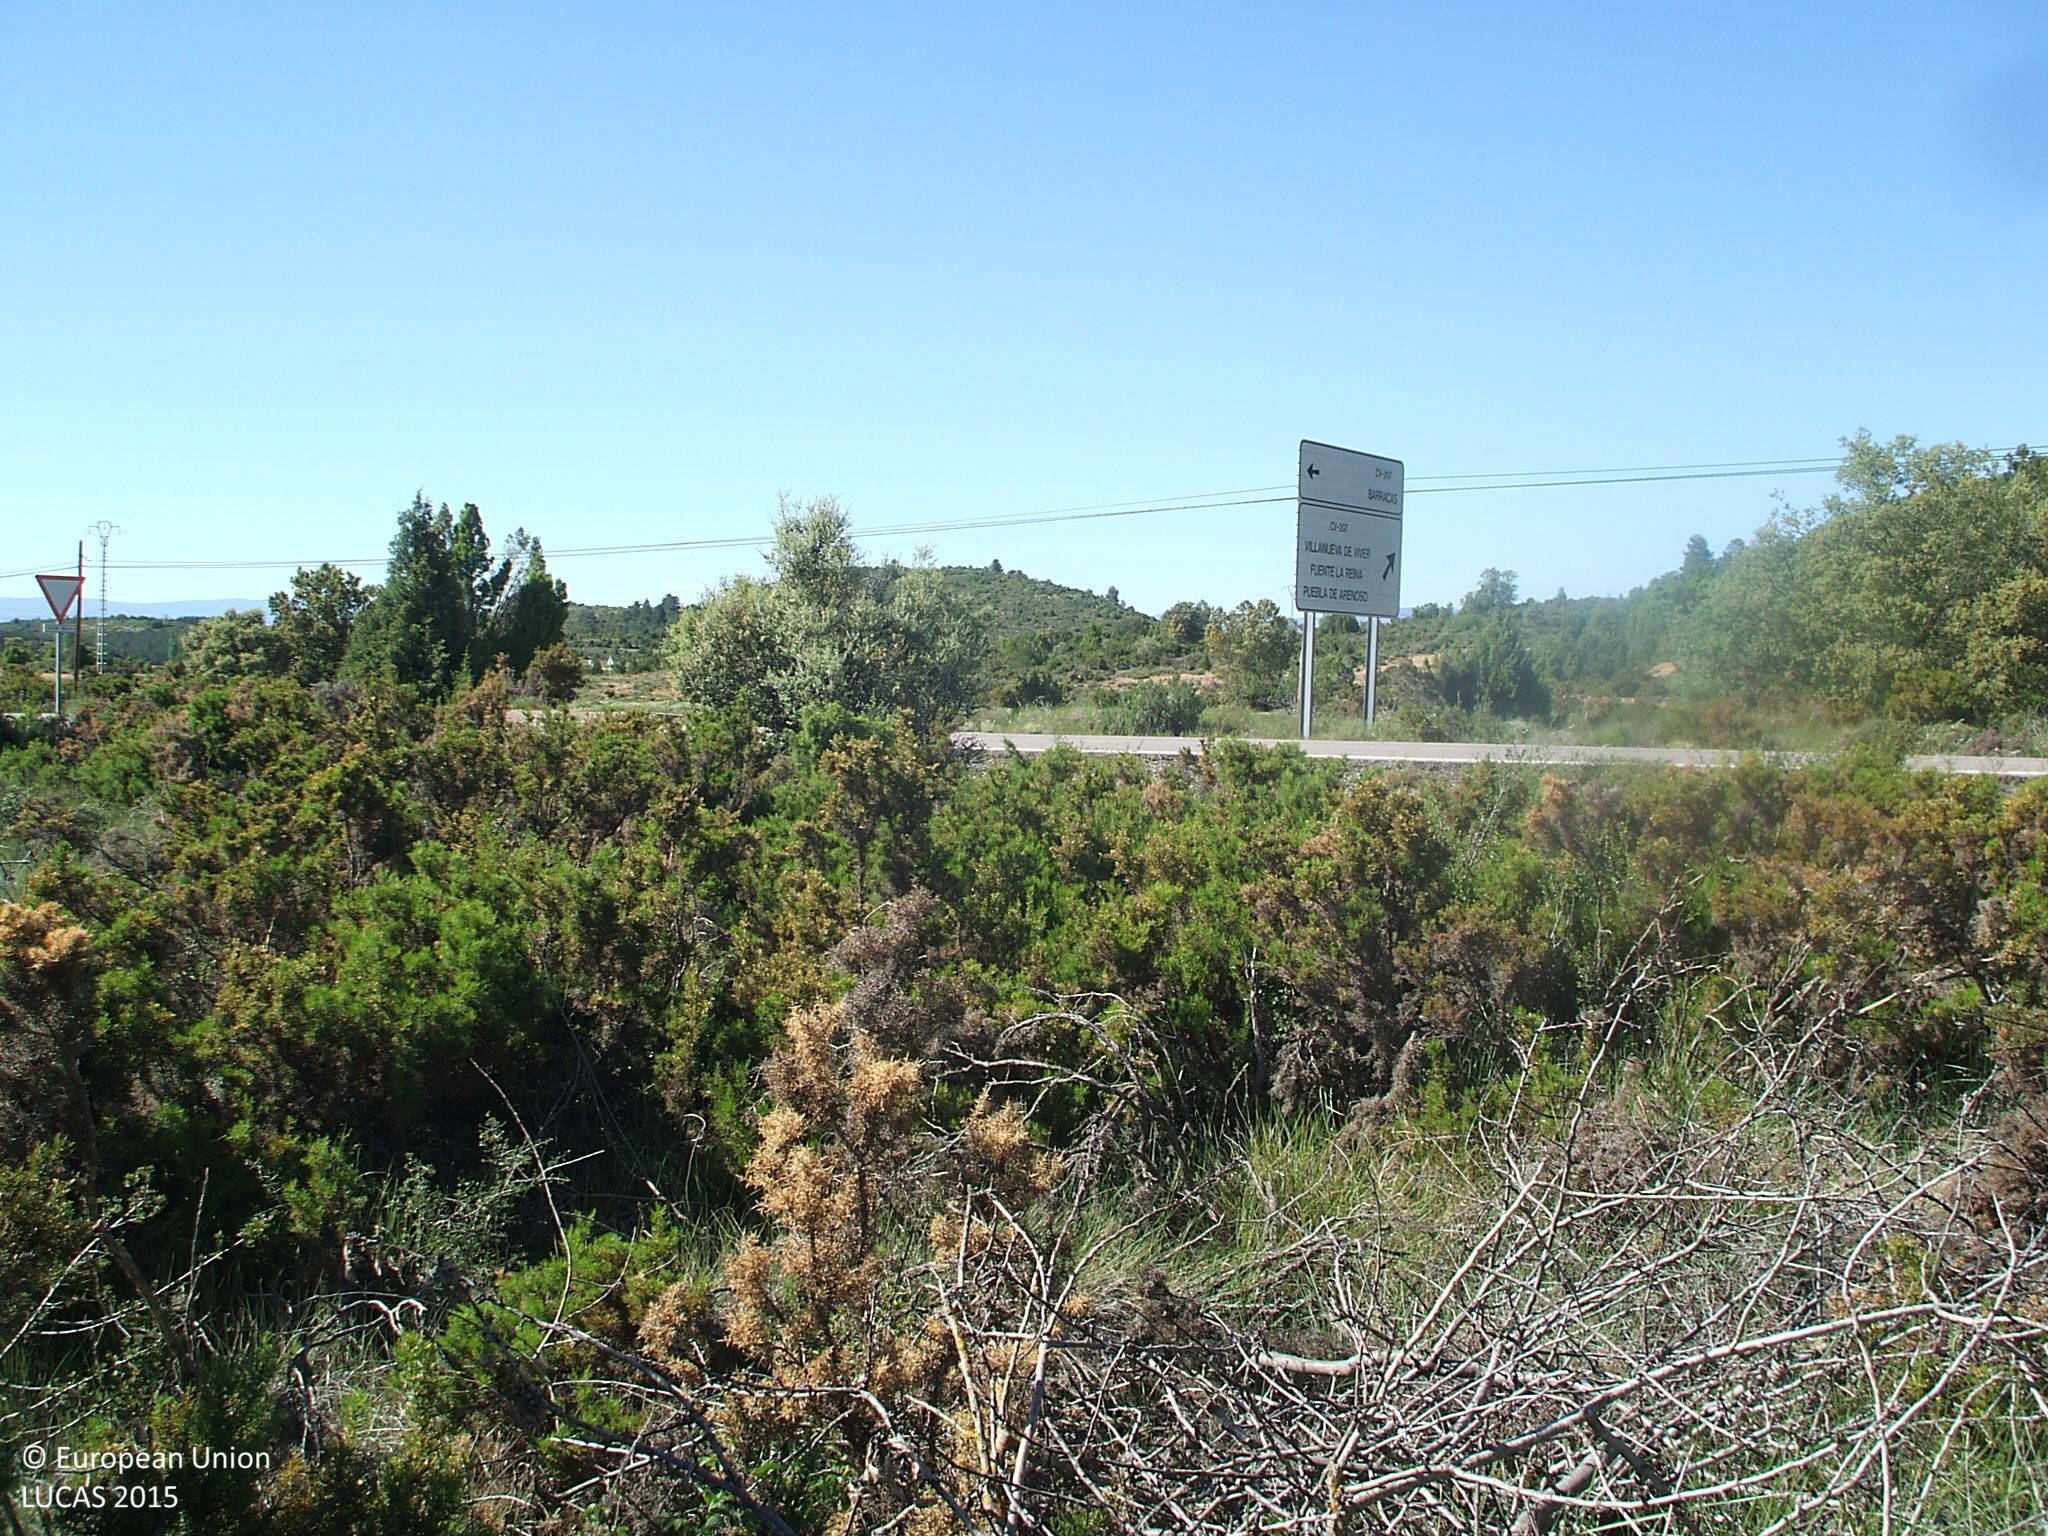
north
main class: Shrubland
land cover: Shrubland with sparse tree cover
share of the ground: 25 - 50 %
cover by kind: unconsolidated bare surface 40 %, shrubs 30 %, herbaceous plants 25 %, coniferous forest trees 5 %
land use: Semi-natural and natural areas not in use
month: May
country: ES
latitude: 40.0291
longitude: -0.6800
